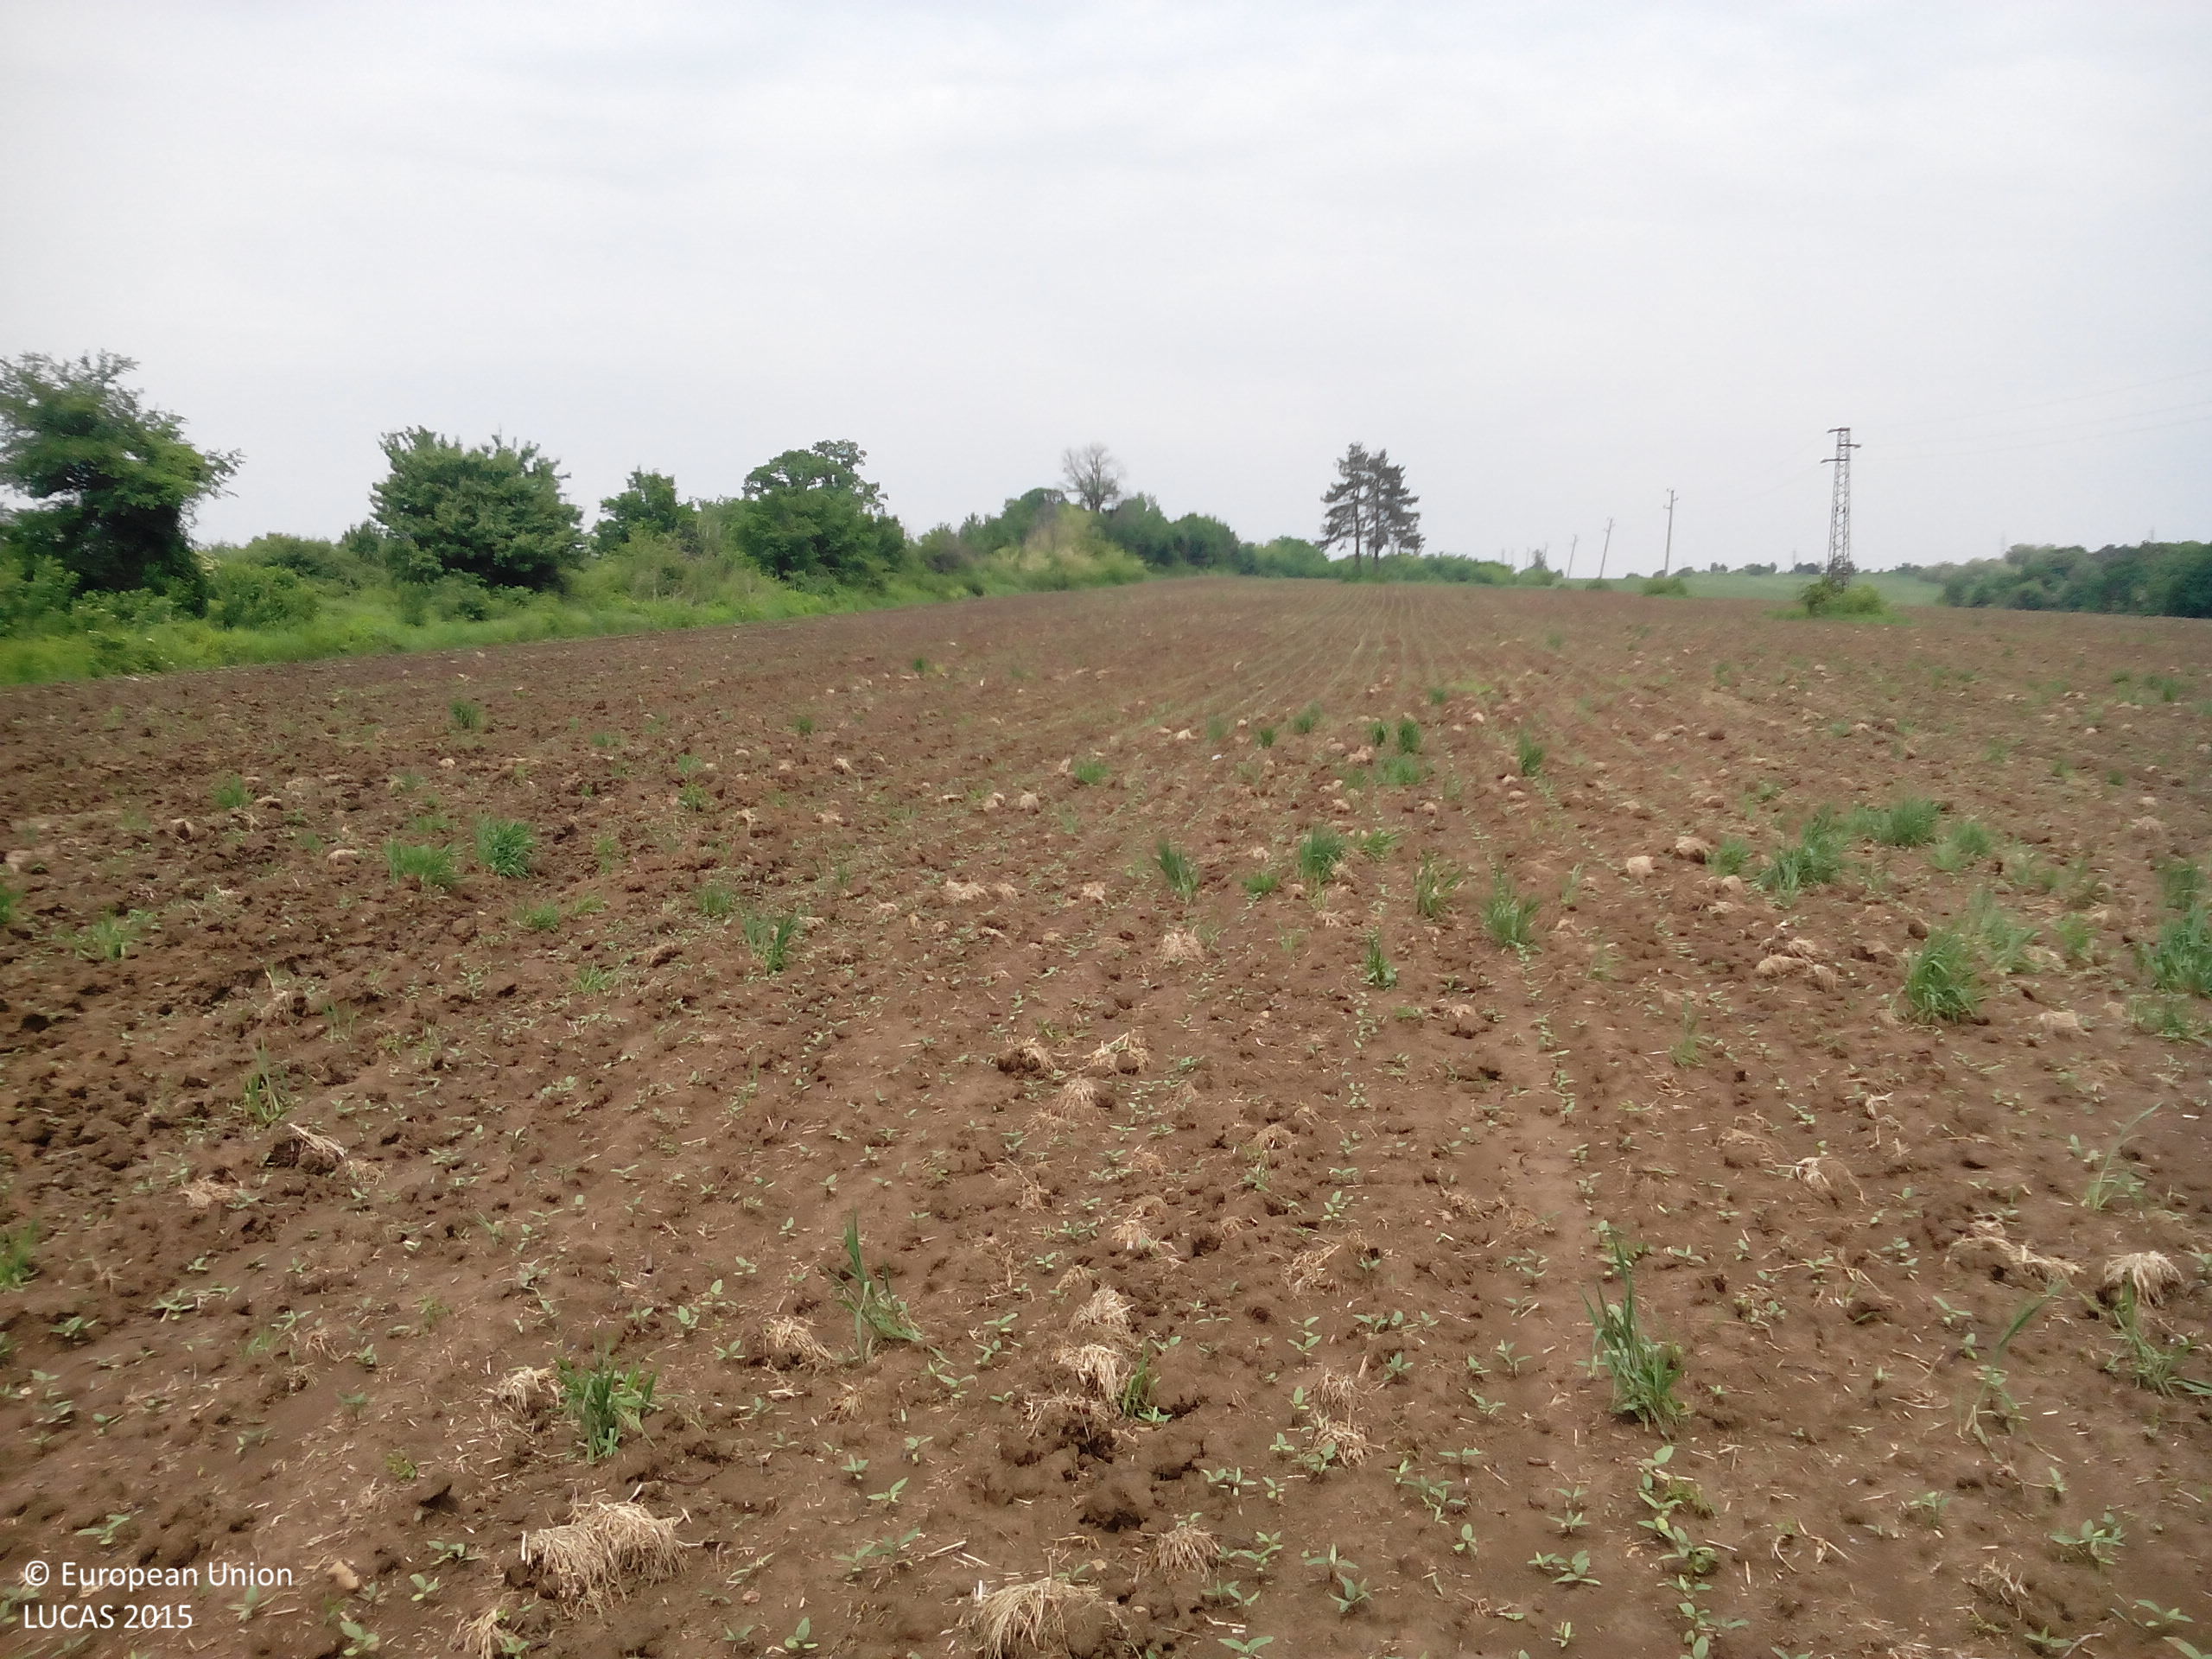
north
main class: Cropland
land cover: Sunflower
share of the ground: < 10 %
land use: Agriculture (excluding fallow land and kitchen gardens)
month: May
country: BG
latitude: 43.2763
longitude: 23.5358
